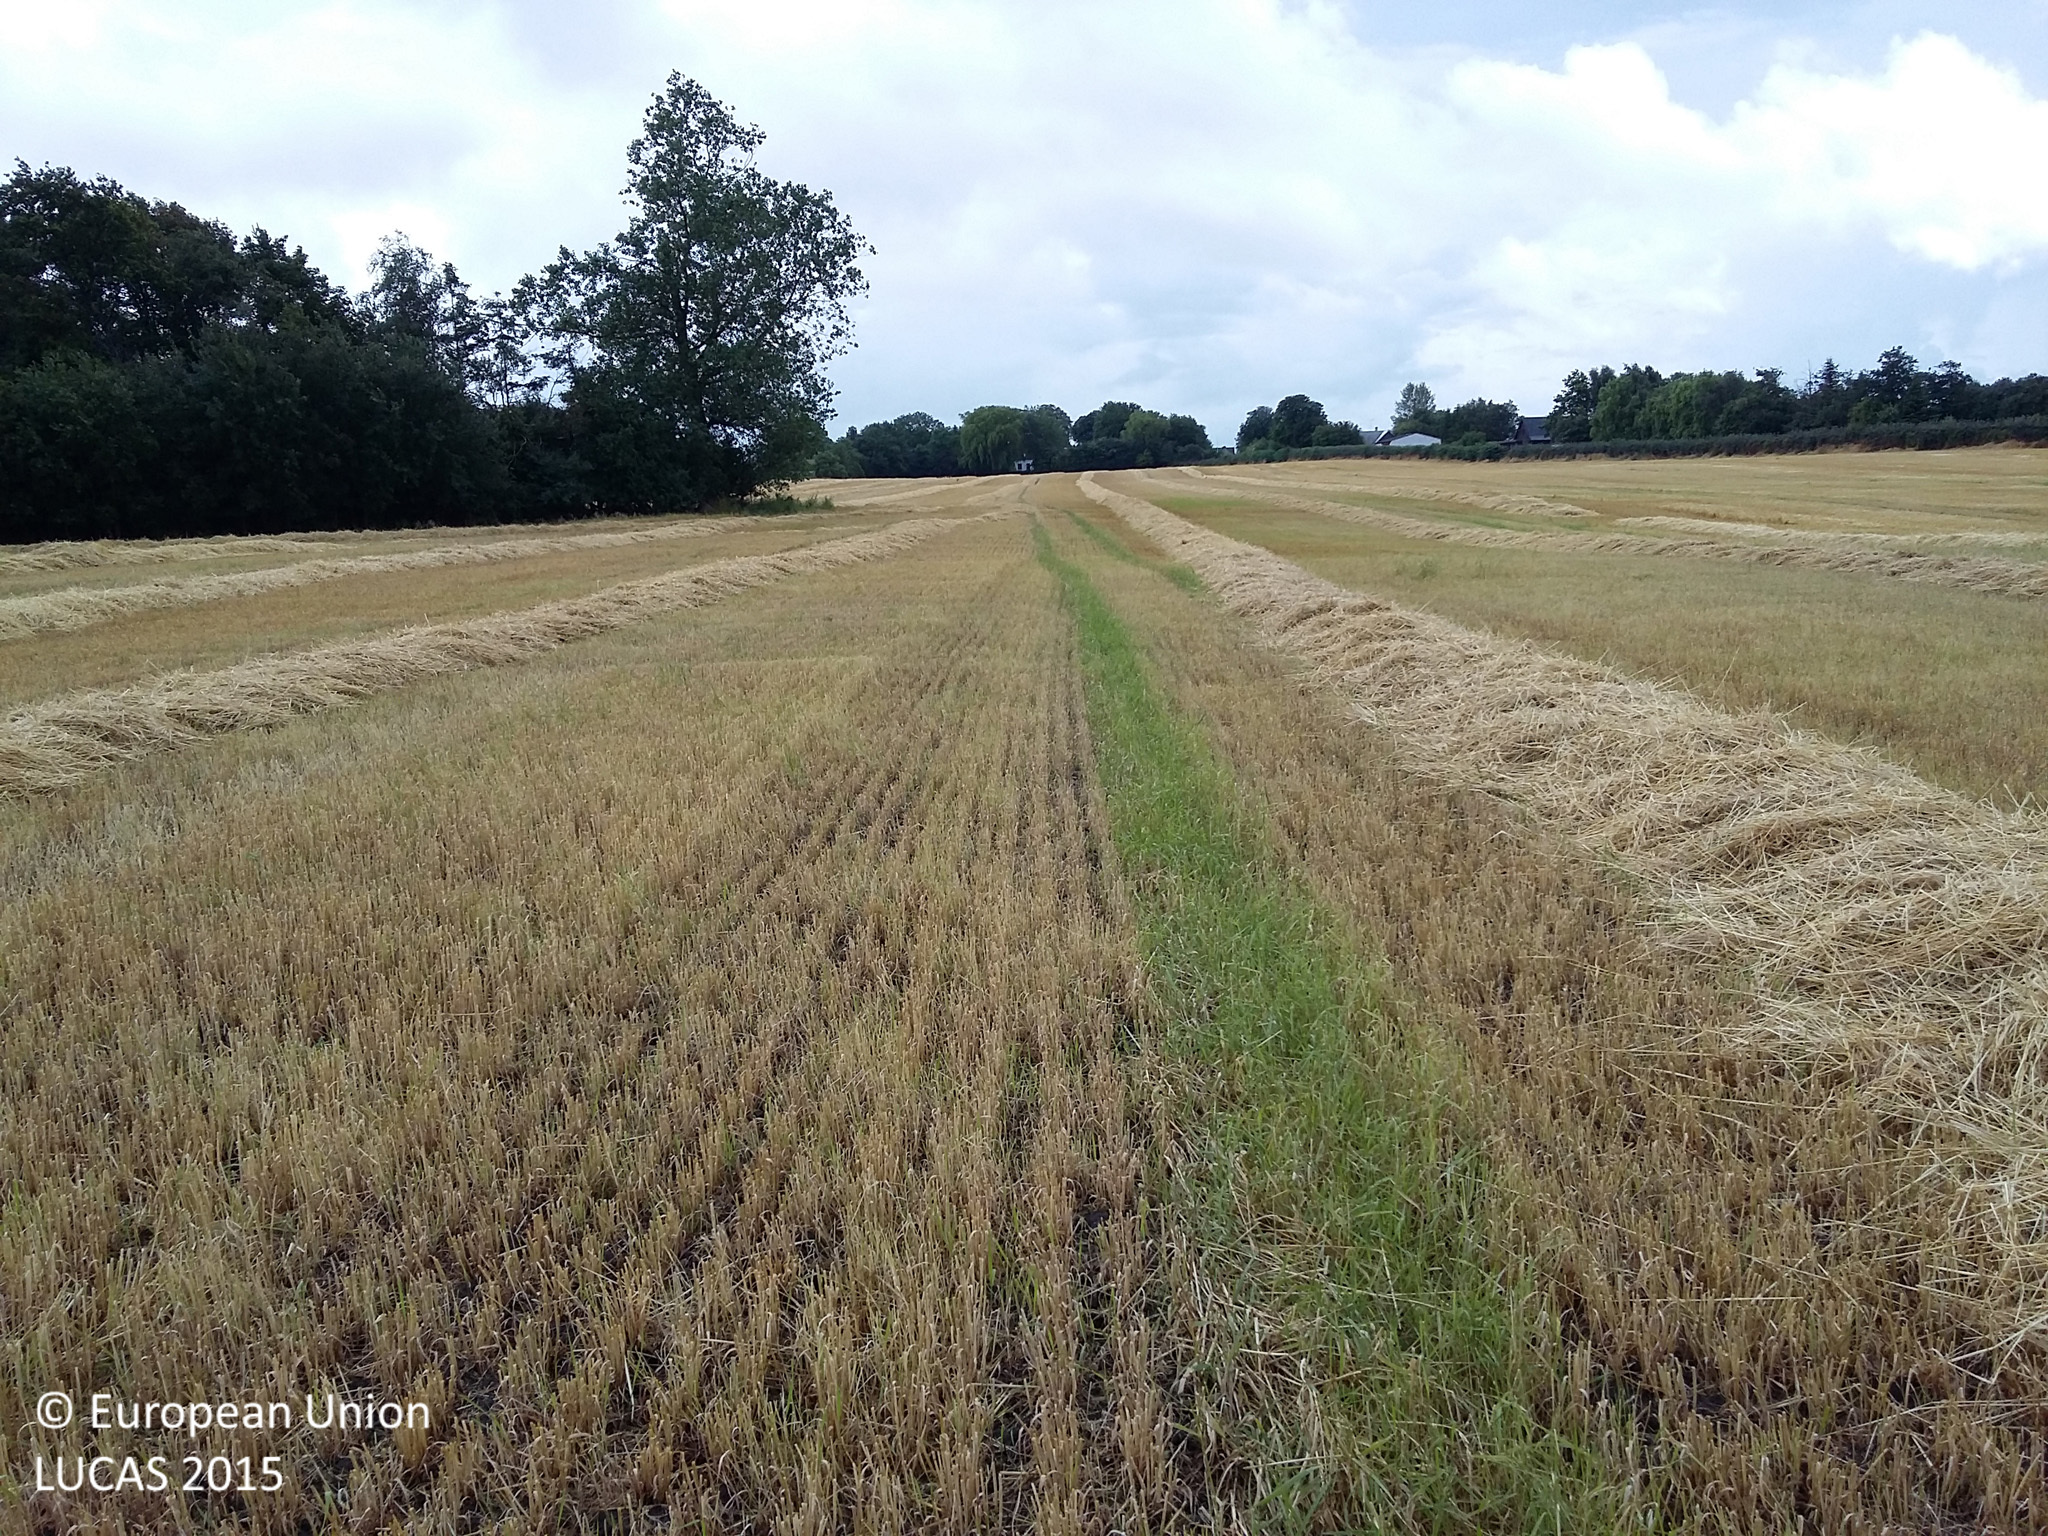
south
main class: Cropland
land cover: Barley
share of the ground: > 75 %
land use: Agriculture (excluding fallow land and kitchen gardens)
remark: Harvested field
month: July
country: DK
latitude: 55.8830
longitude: 12.0923
